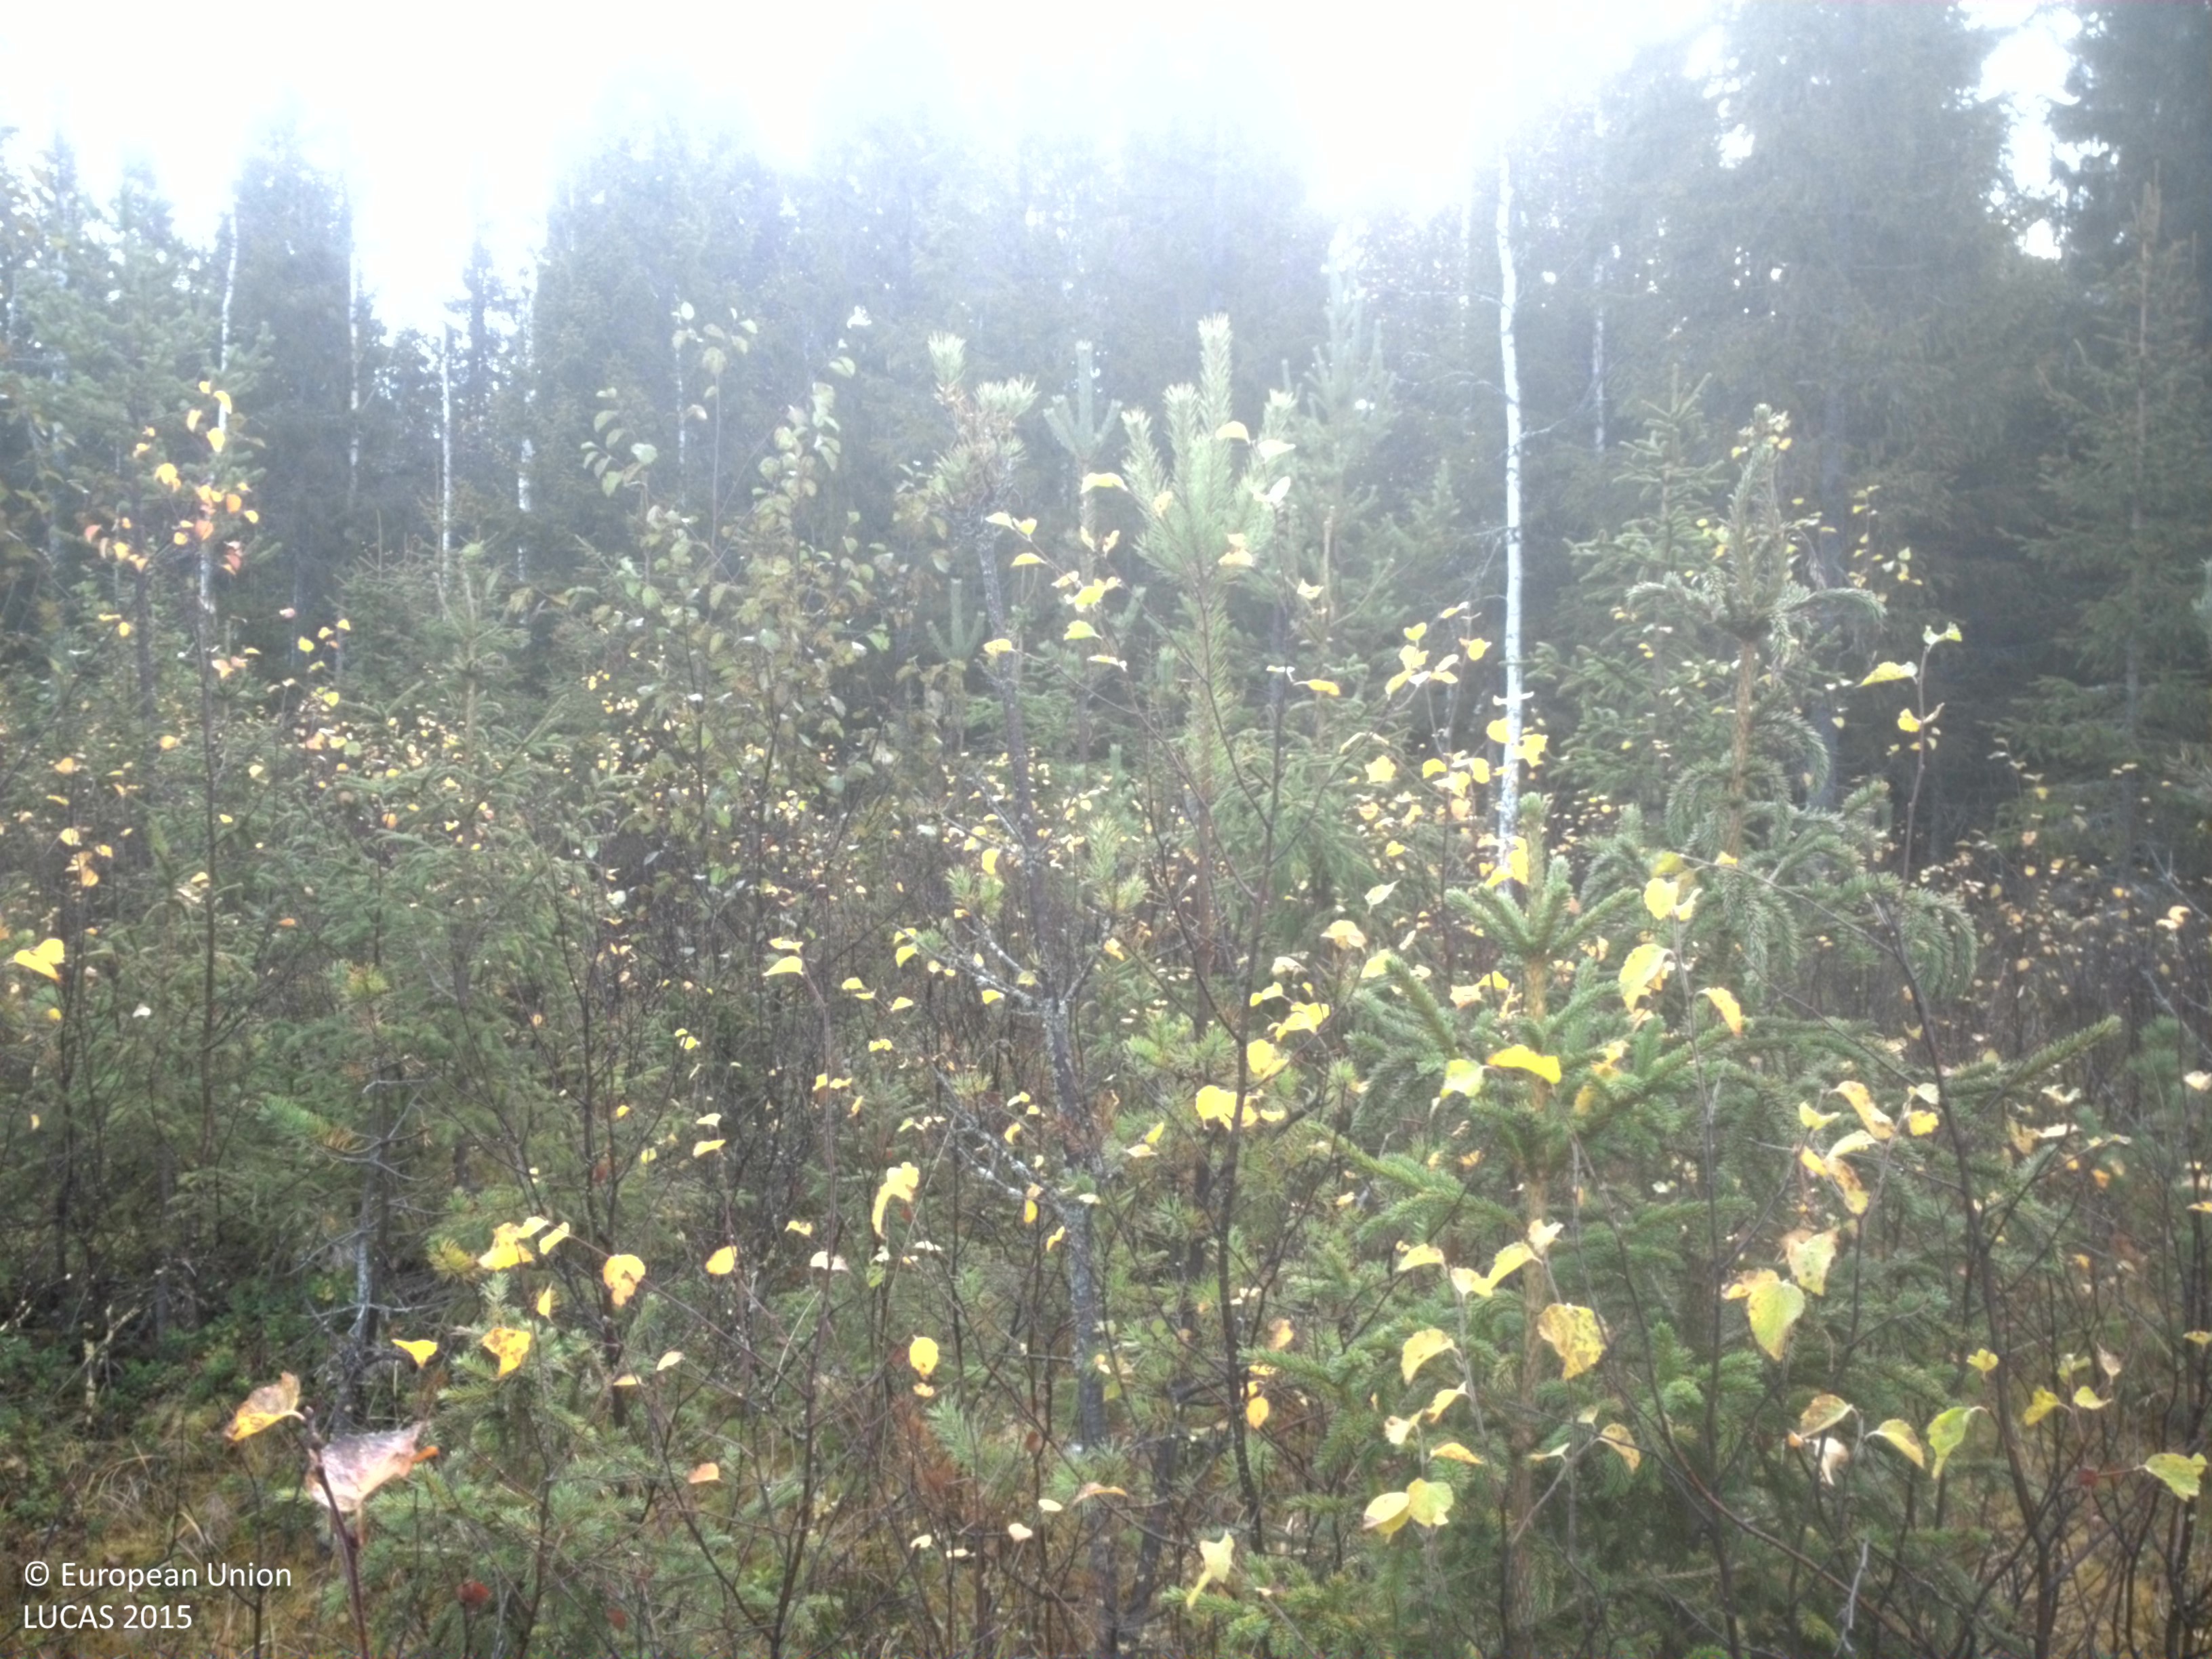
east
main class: Woodland
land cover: Other mixed woodland
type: boreal forest
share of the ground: > 75 %
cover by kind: coniferous forest trees 40 %, broadleaved forest trees 40 %, lichens and mosses 10 %, shrubs 5 %, herbaceous plants 5 %
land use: Forestry
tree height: > 5 m
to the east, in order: Other mixed woodland; Spruce dominated coniferous woodland; Rivers and streams; Spruce dominated coniferous woodland; Spruce dominated mixed woodland; Spruce dominated coniferous woodland; Pine dominated mixed woodland; Other mixed woodland
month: October
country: SE
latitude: 64.1274
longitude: 19.8561
